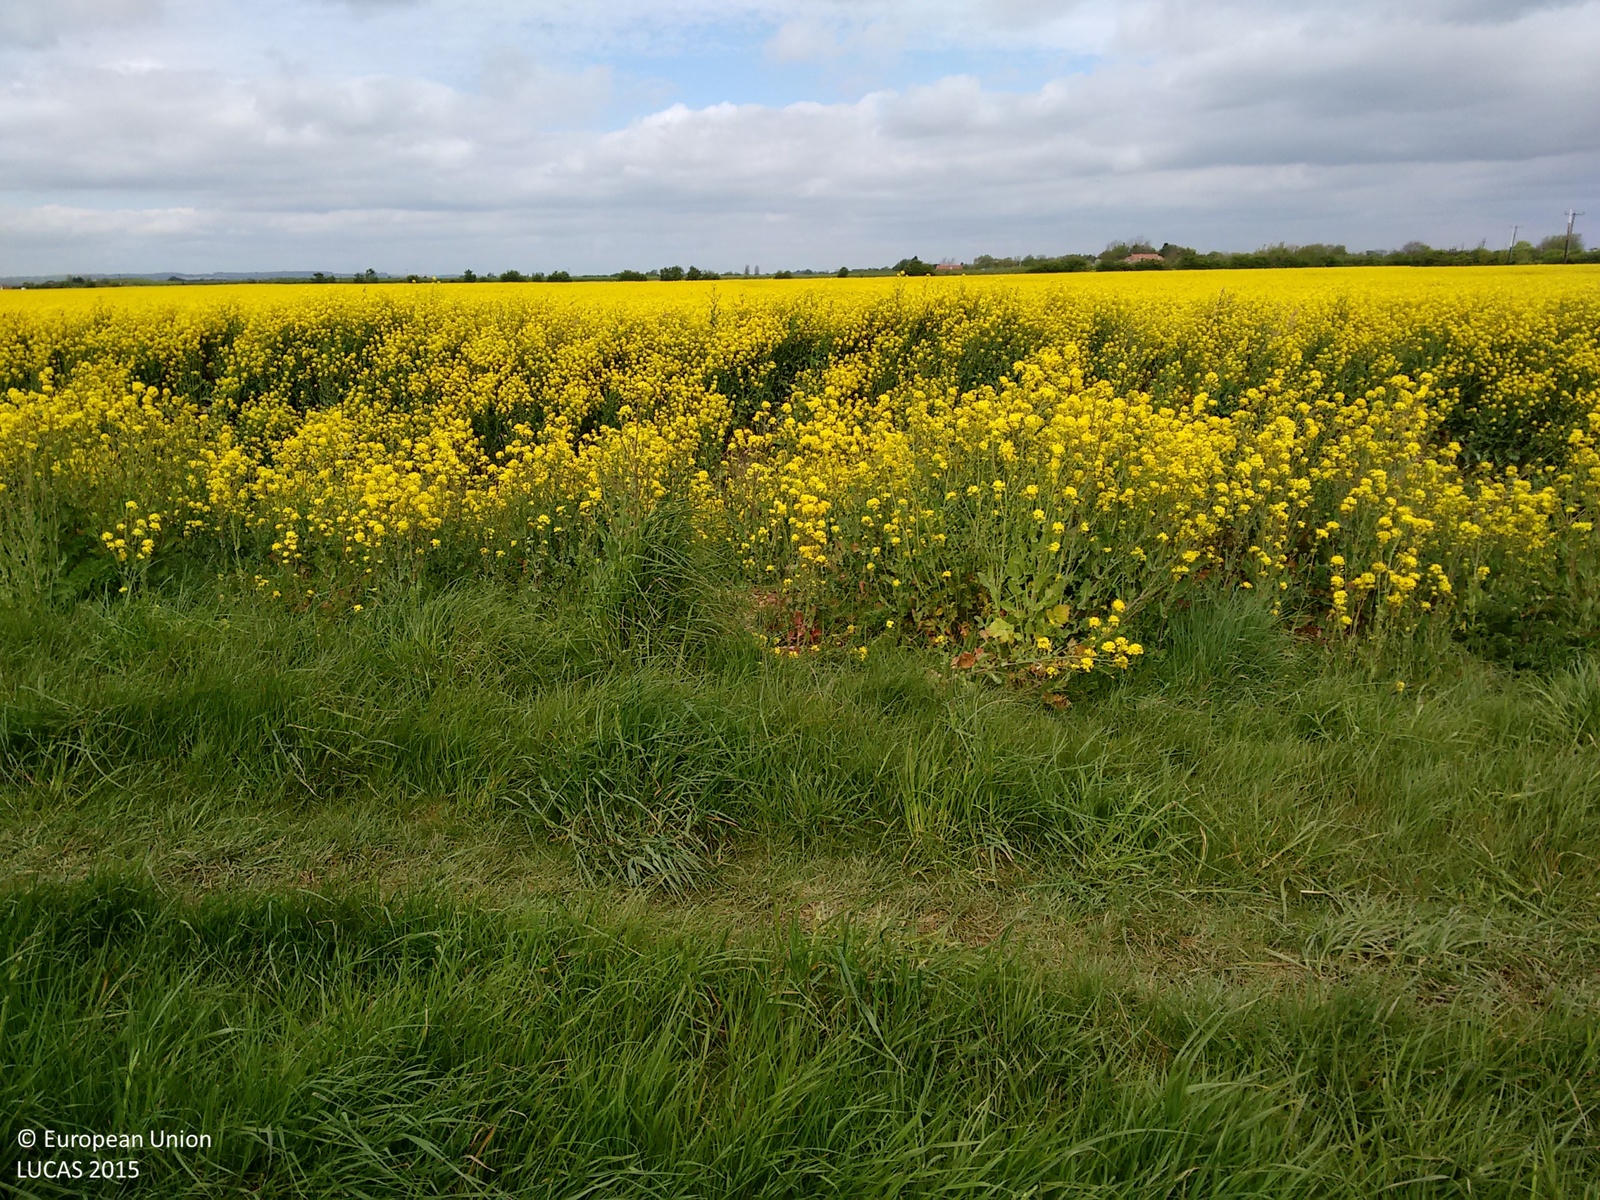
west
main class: Cropland
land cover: Rape and turnip rape
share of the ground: > 75 %
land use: Agriculture (excluding fallow land and kitchen gardens)
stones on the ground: < 10 %
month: May
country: GB
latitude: 53.2120
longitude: 0.3129
